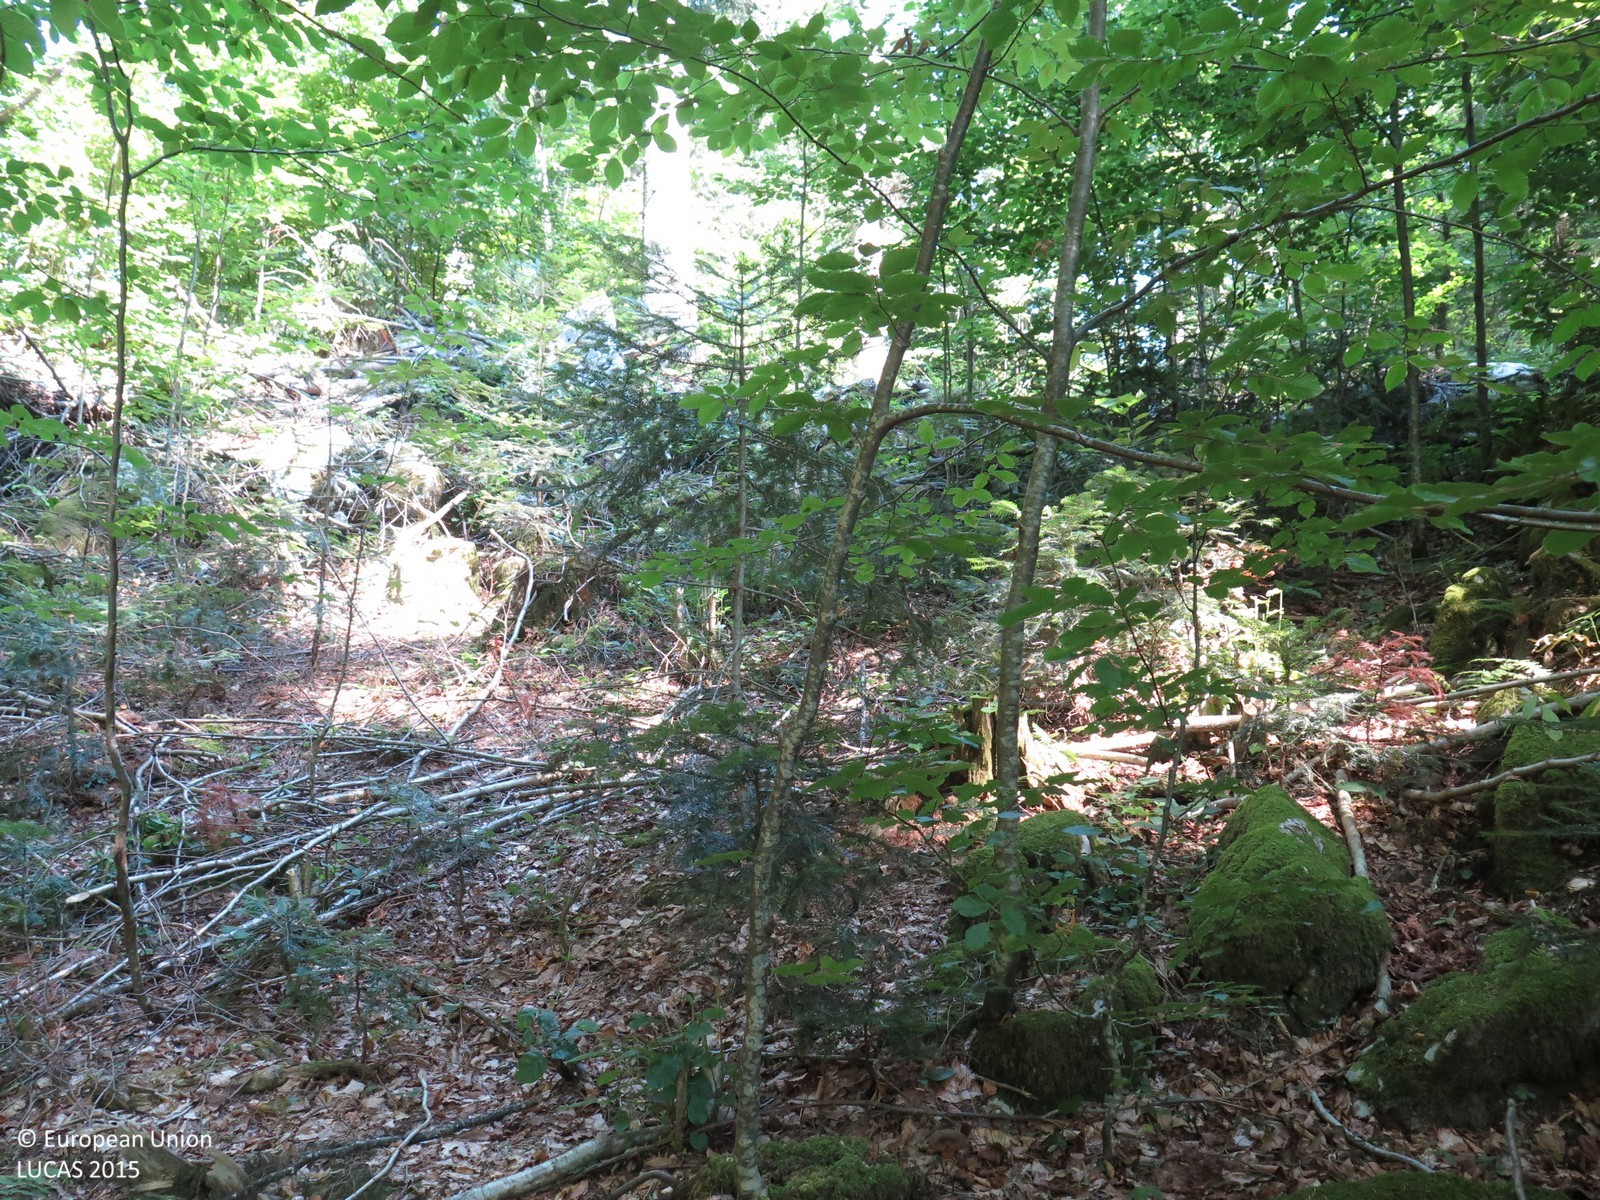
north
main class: Woodland
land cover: Other mixed woodland
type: beech forest
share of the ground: > 75 %
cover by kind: broadleaved forest trees 75 %, coniferous forest trees 25 %
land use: Forestry
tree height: > 5 m
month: August
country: HR
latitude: 45.4188
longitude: 15.0689
